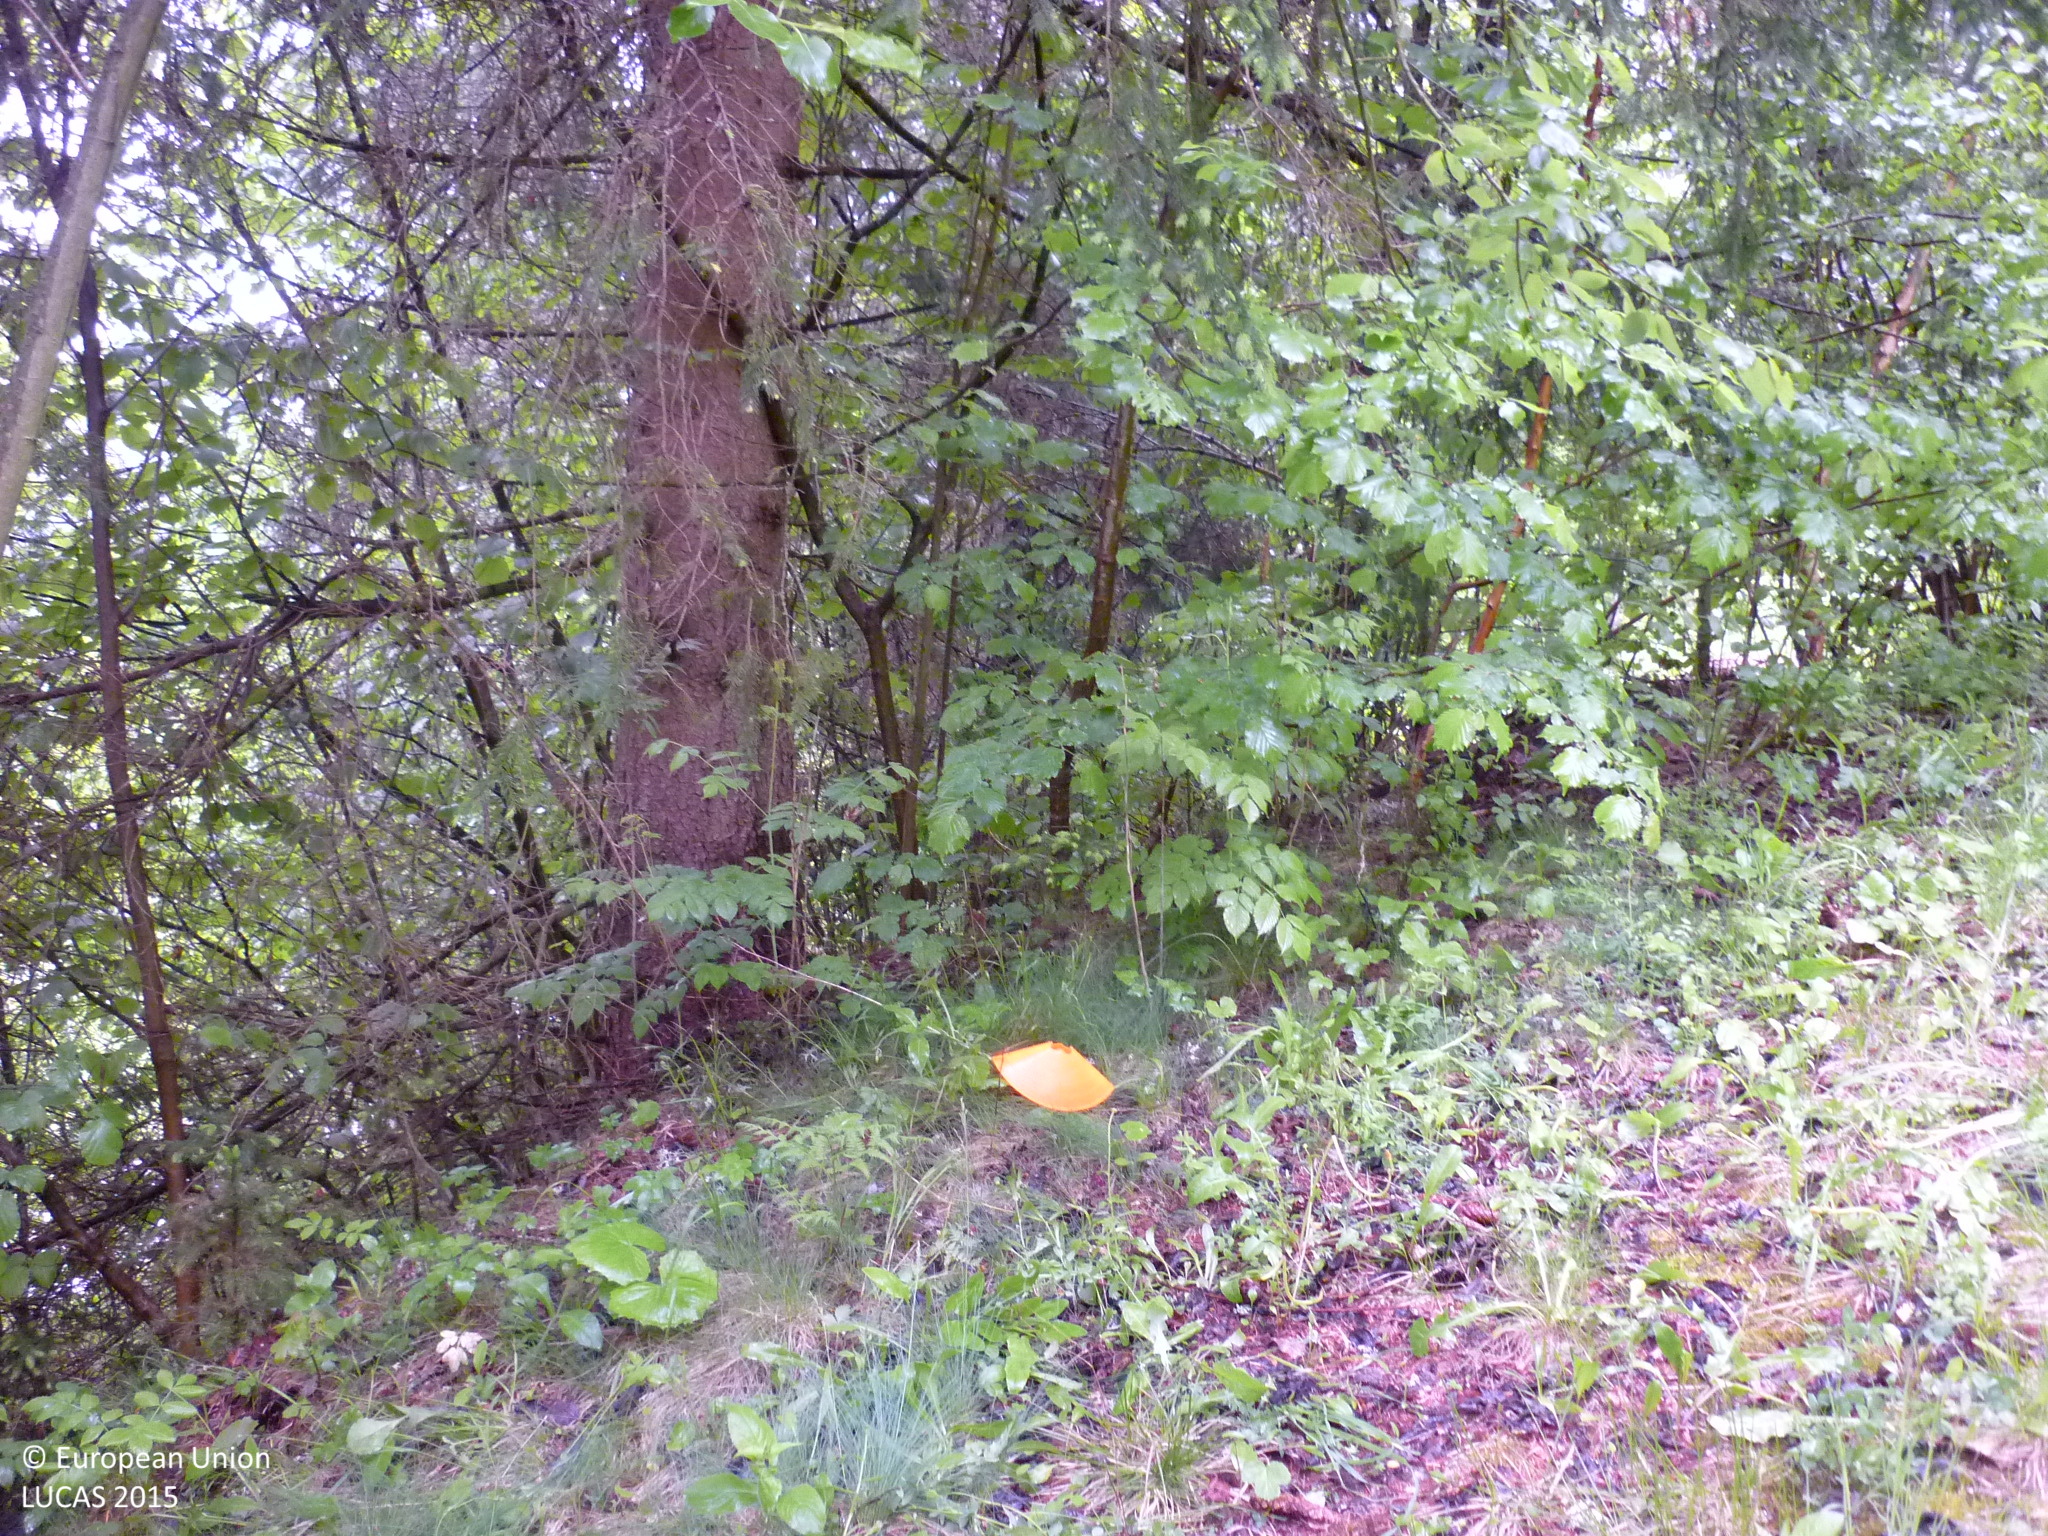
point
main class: Woodland
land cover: Spruce dominated mixed woodland
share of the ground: > 75 %
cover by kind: coniferous forest trees 45 %, broadleaved forest trees 30 %, herbaceous plants 25 %
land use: Forestry
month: May
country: AT
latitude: 47.1032
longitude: 14.0696
